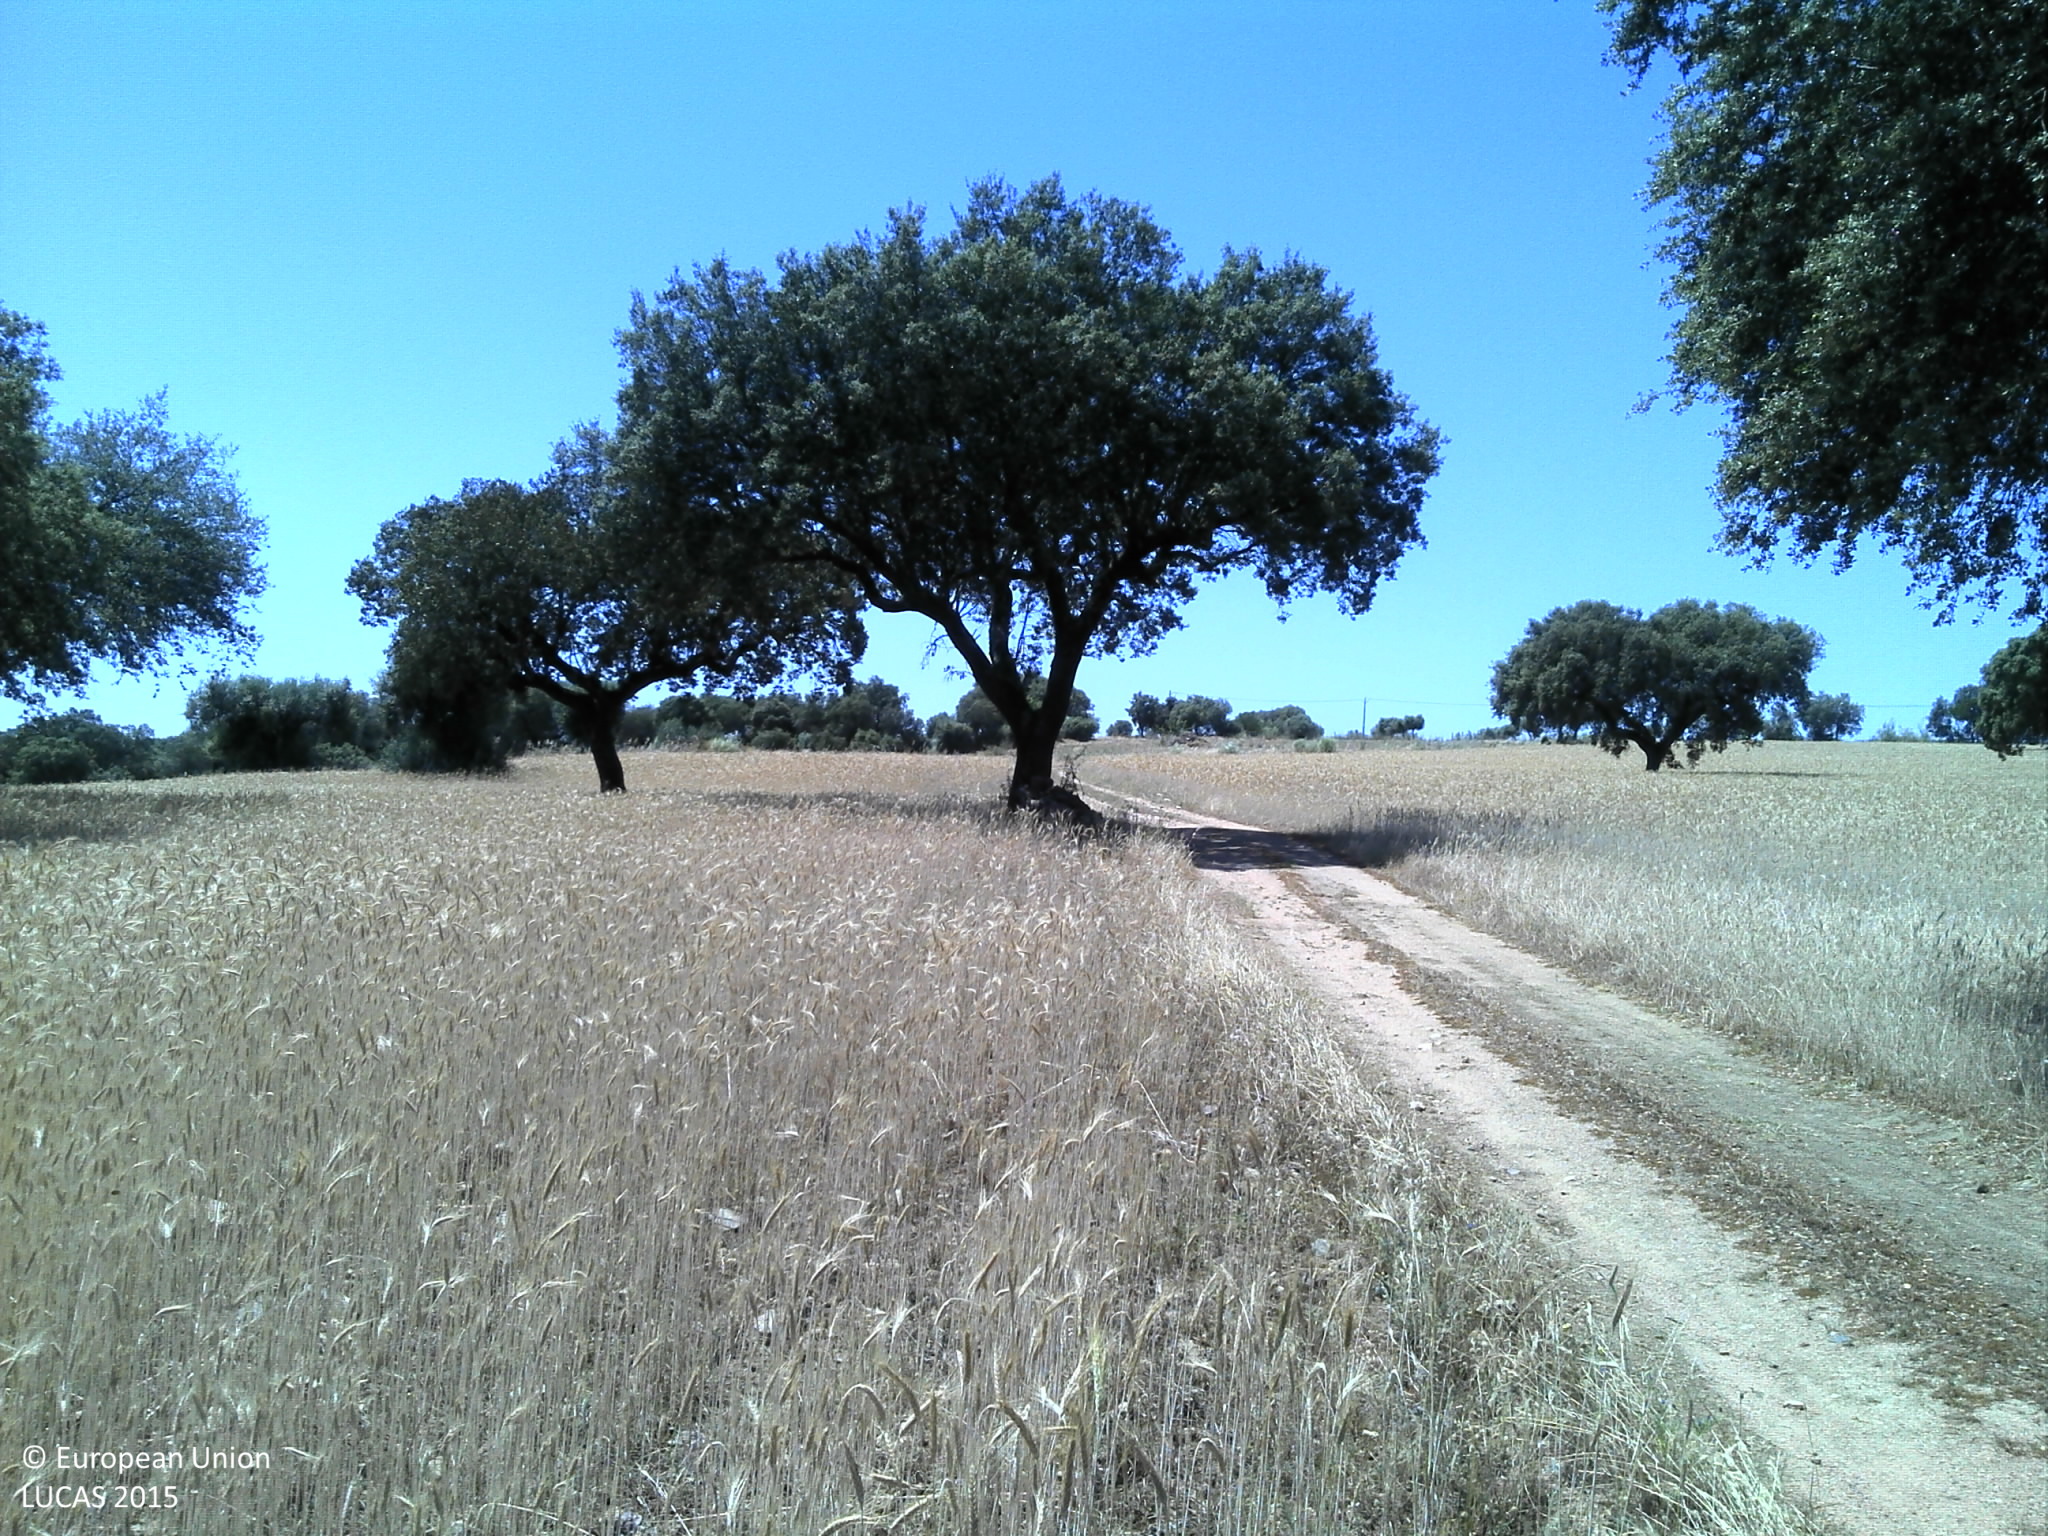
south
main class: Woodland
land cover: Broadleaved woodland
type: broadleaved evergreen forest
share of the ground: 25 - 50 %
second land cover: Triticale
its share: 50 - 75 %
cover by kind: herbaceous plants 60 %, broadleaved forest trees 30 %, unconsolidated bare surface 10 %
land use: Forestry
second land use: Agriculture (excluding fallow land and kitchen gardens)
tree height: > 5 m
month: May
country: PT
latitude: 39.0160
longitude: -7.5834
